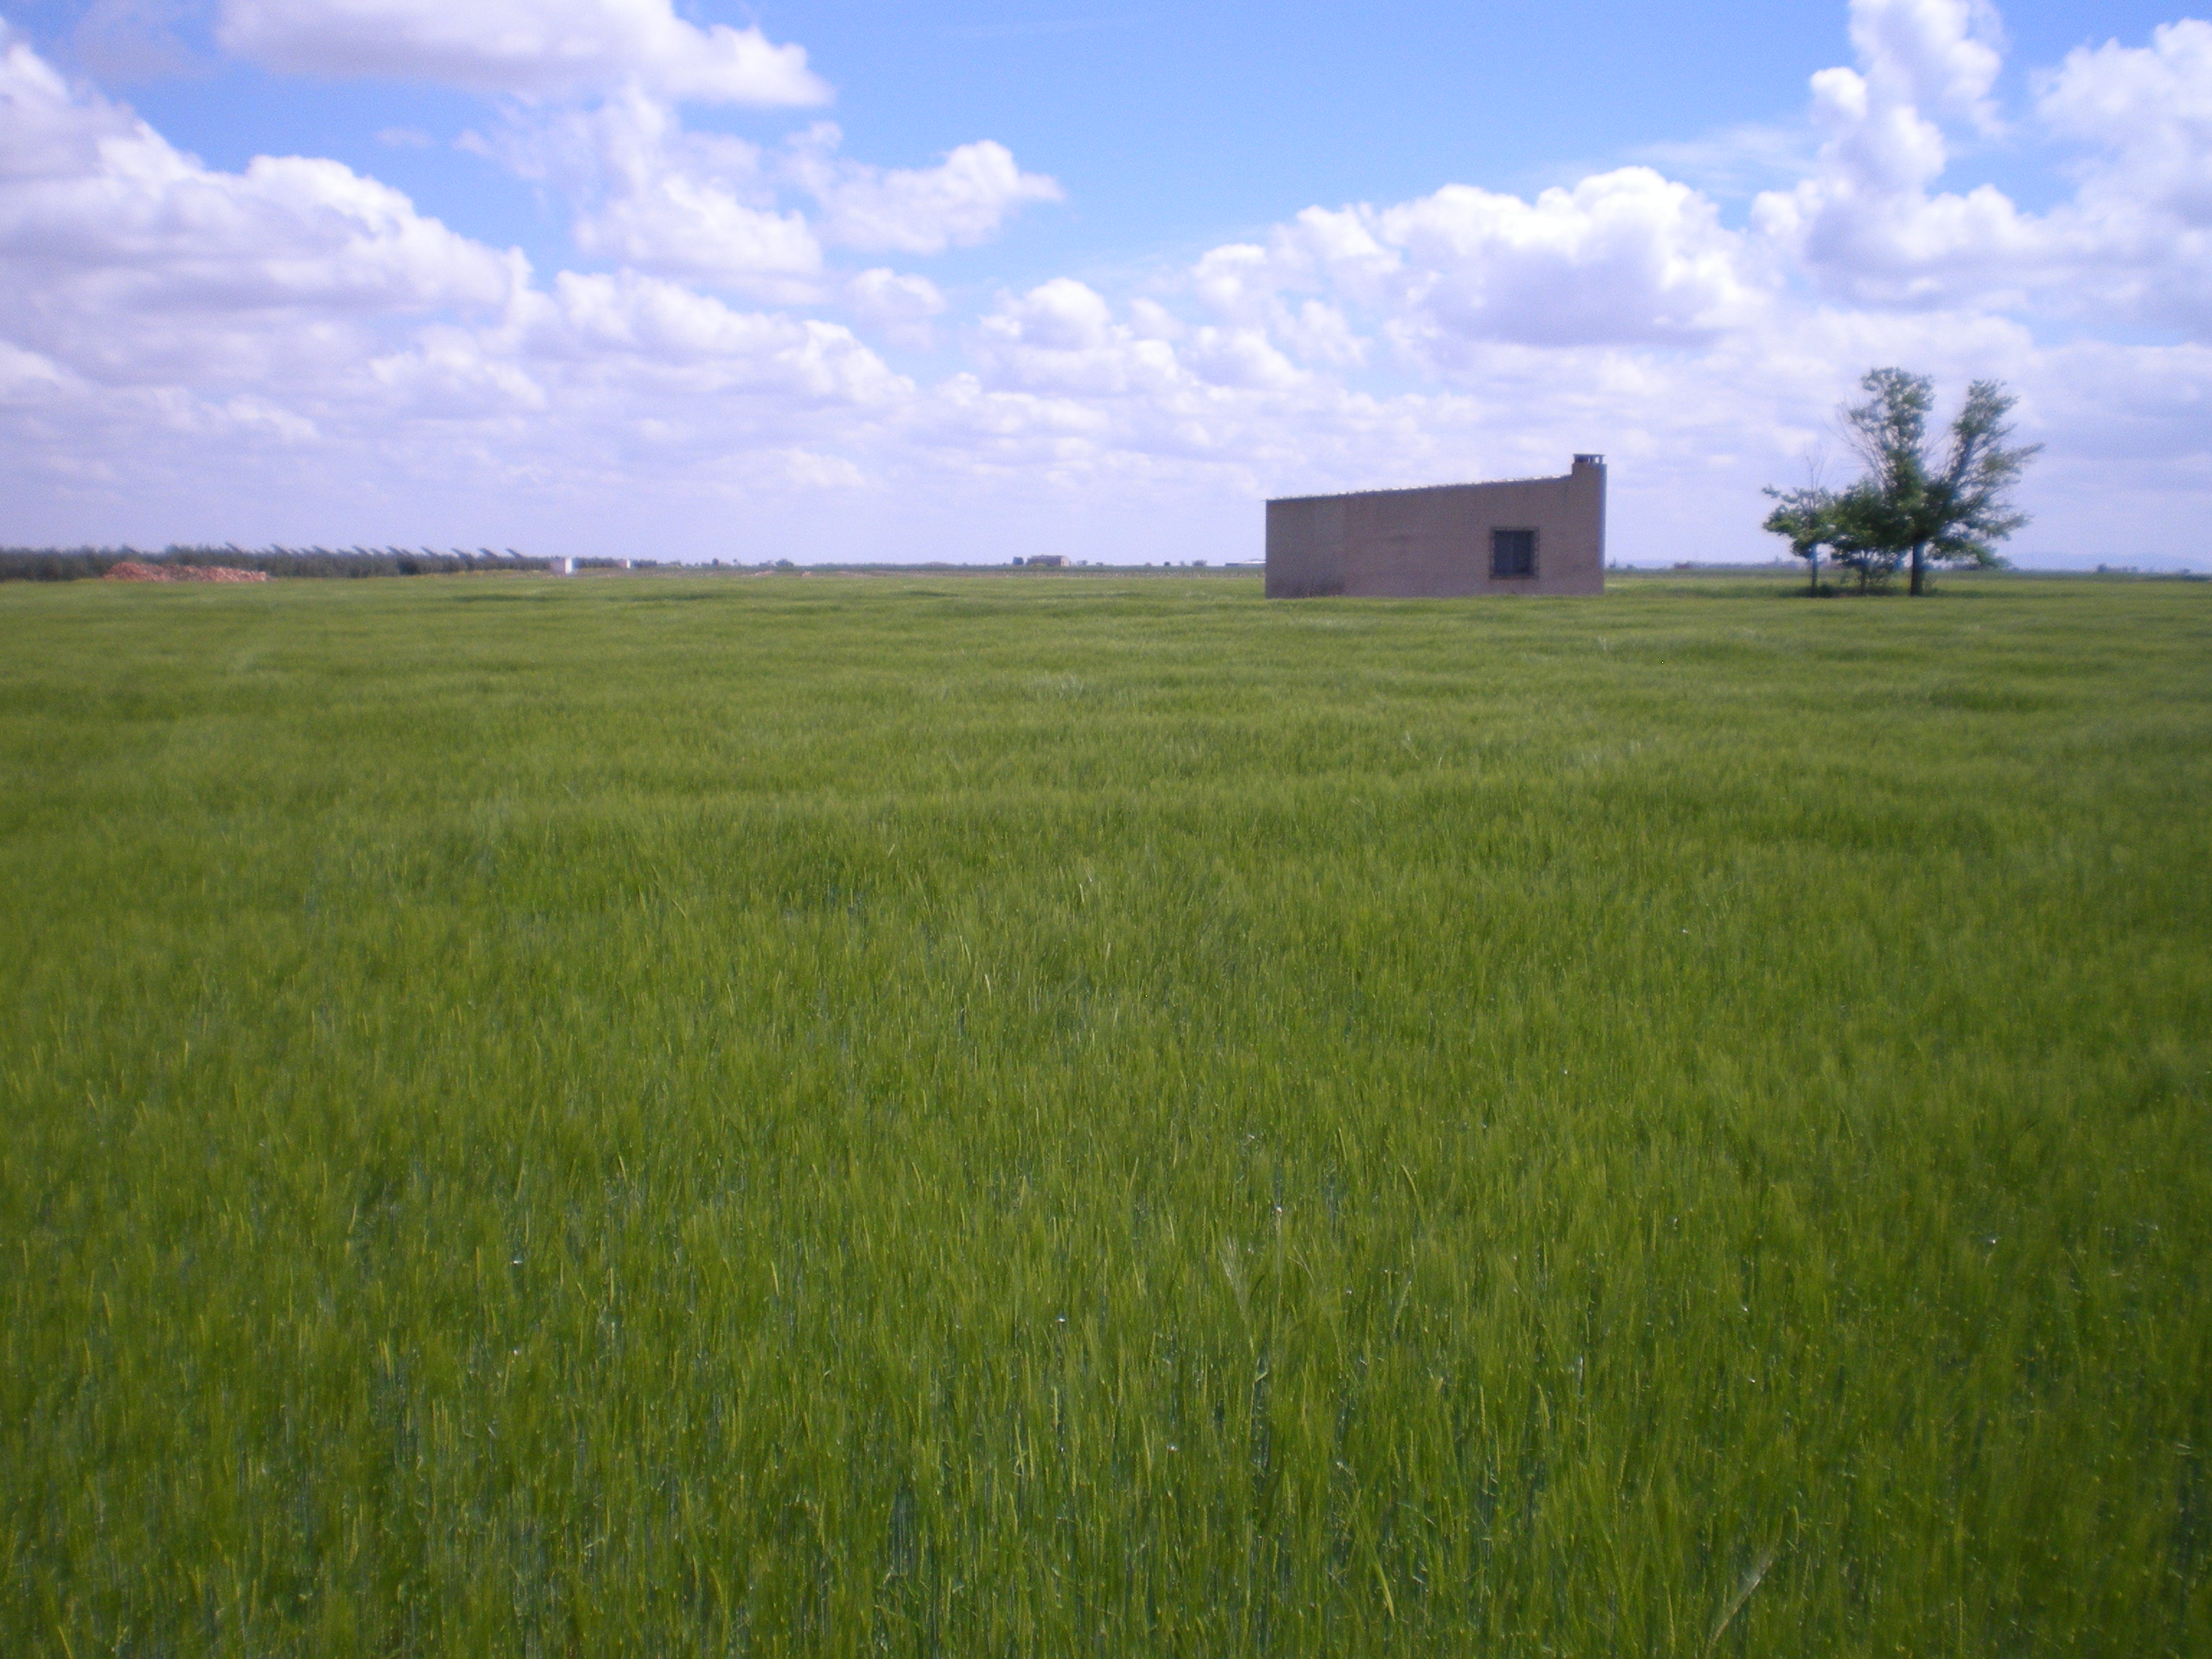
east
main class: Cropland
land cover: Barley
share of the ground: > 75 %
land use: Agriculture (excluding fallow land and kitchen gardens)
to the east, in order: Barley; Grass margins; Tracks; Grass margins; Barley; Grass margins; Olive groves
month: April
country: ES
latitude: 38.9882
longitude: -3.5815
